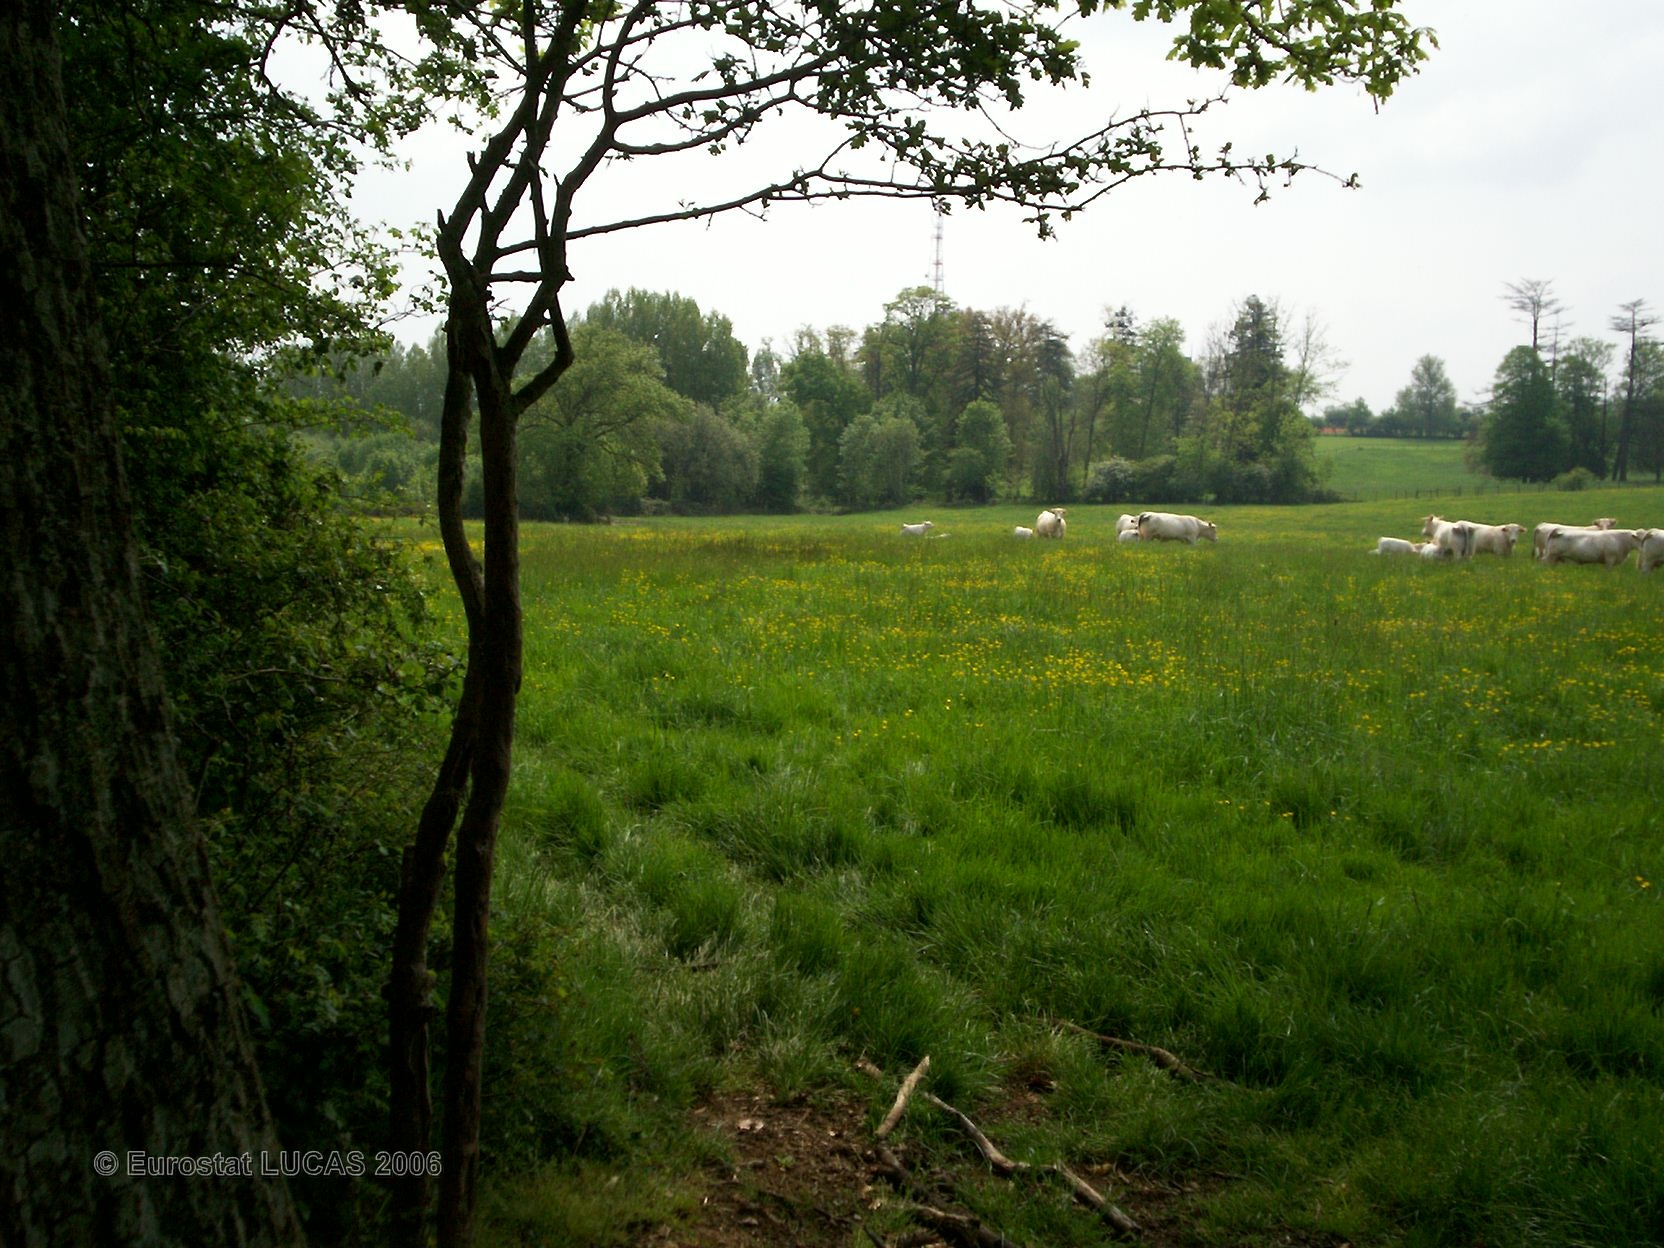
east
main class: Grassland
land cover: Grassland without tree/shrub cover
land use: Agriculture (excluding fallow land and kitchen gardens)
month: May
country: FR
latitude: 48.4644
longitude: 0.0852
